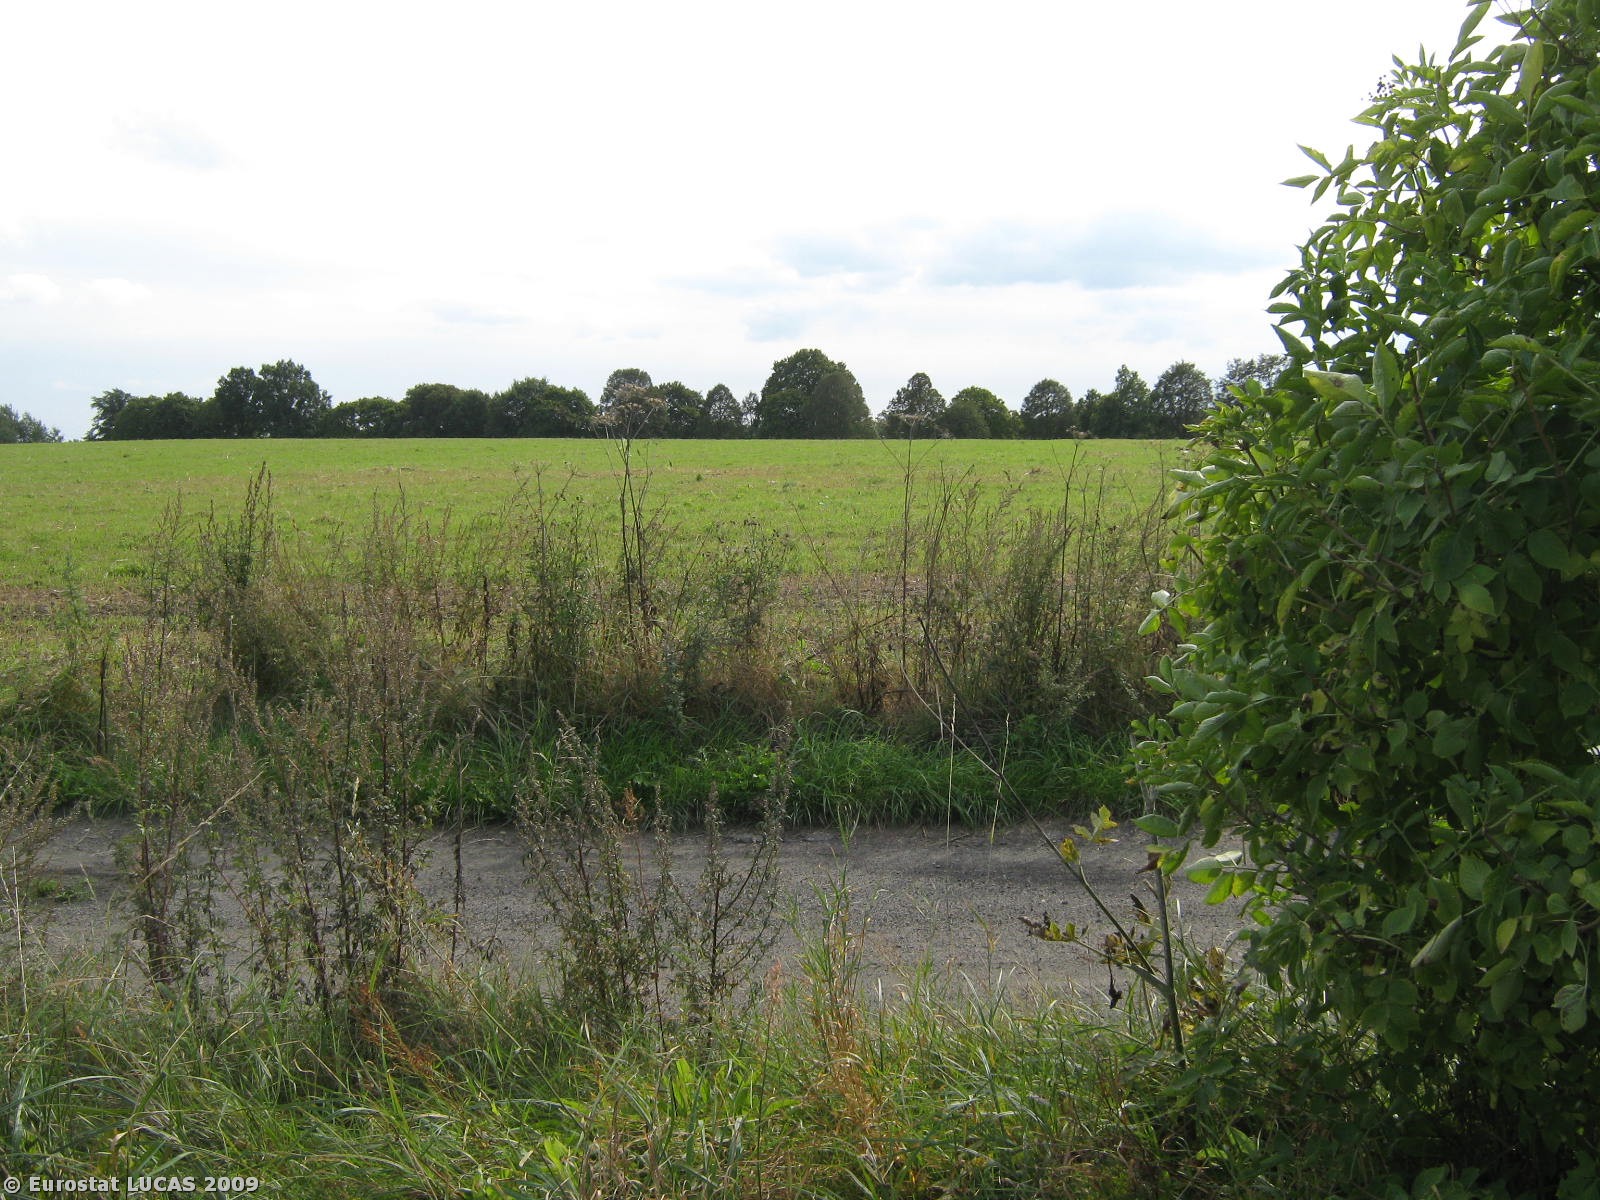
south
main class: Cropland
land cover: Common wheat
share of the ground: < 10 %
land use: Agriculture (excluding fallow land and kitchen gardens)
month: September
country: PL
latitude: 53.9256
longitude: 15.5005
